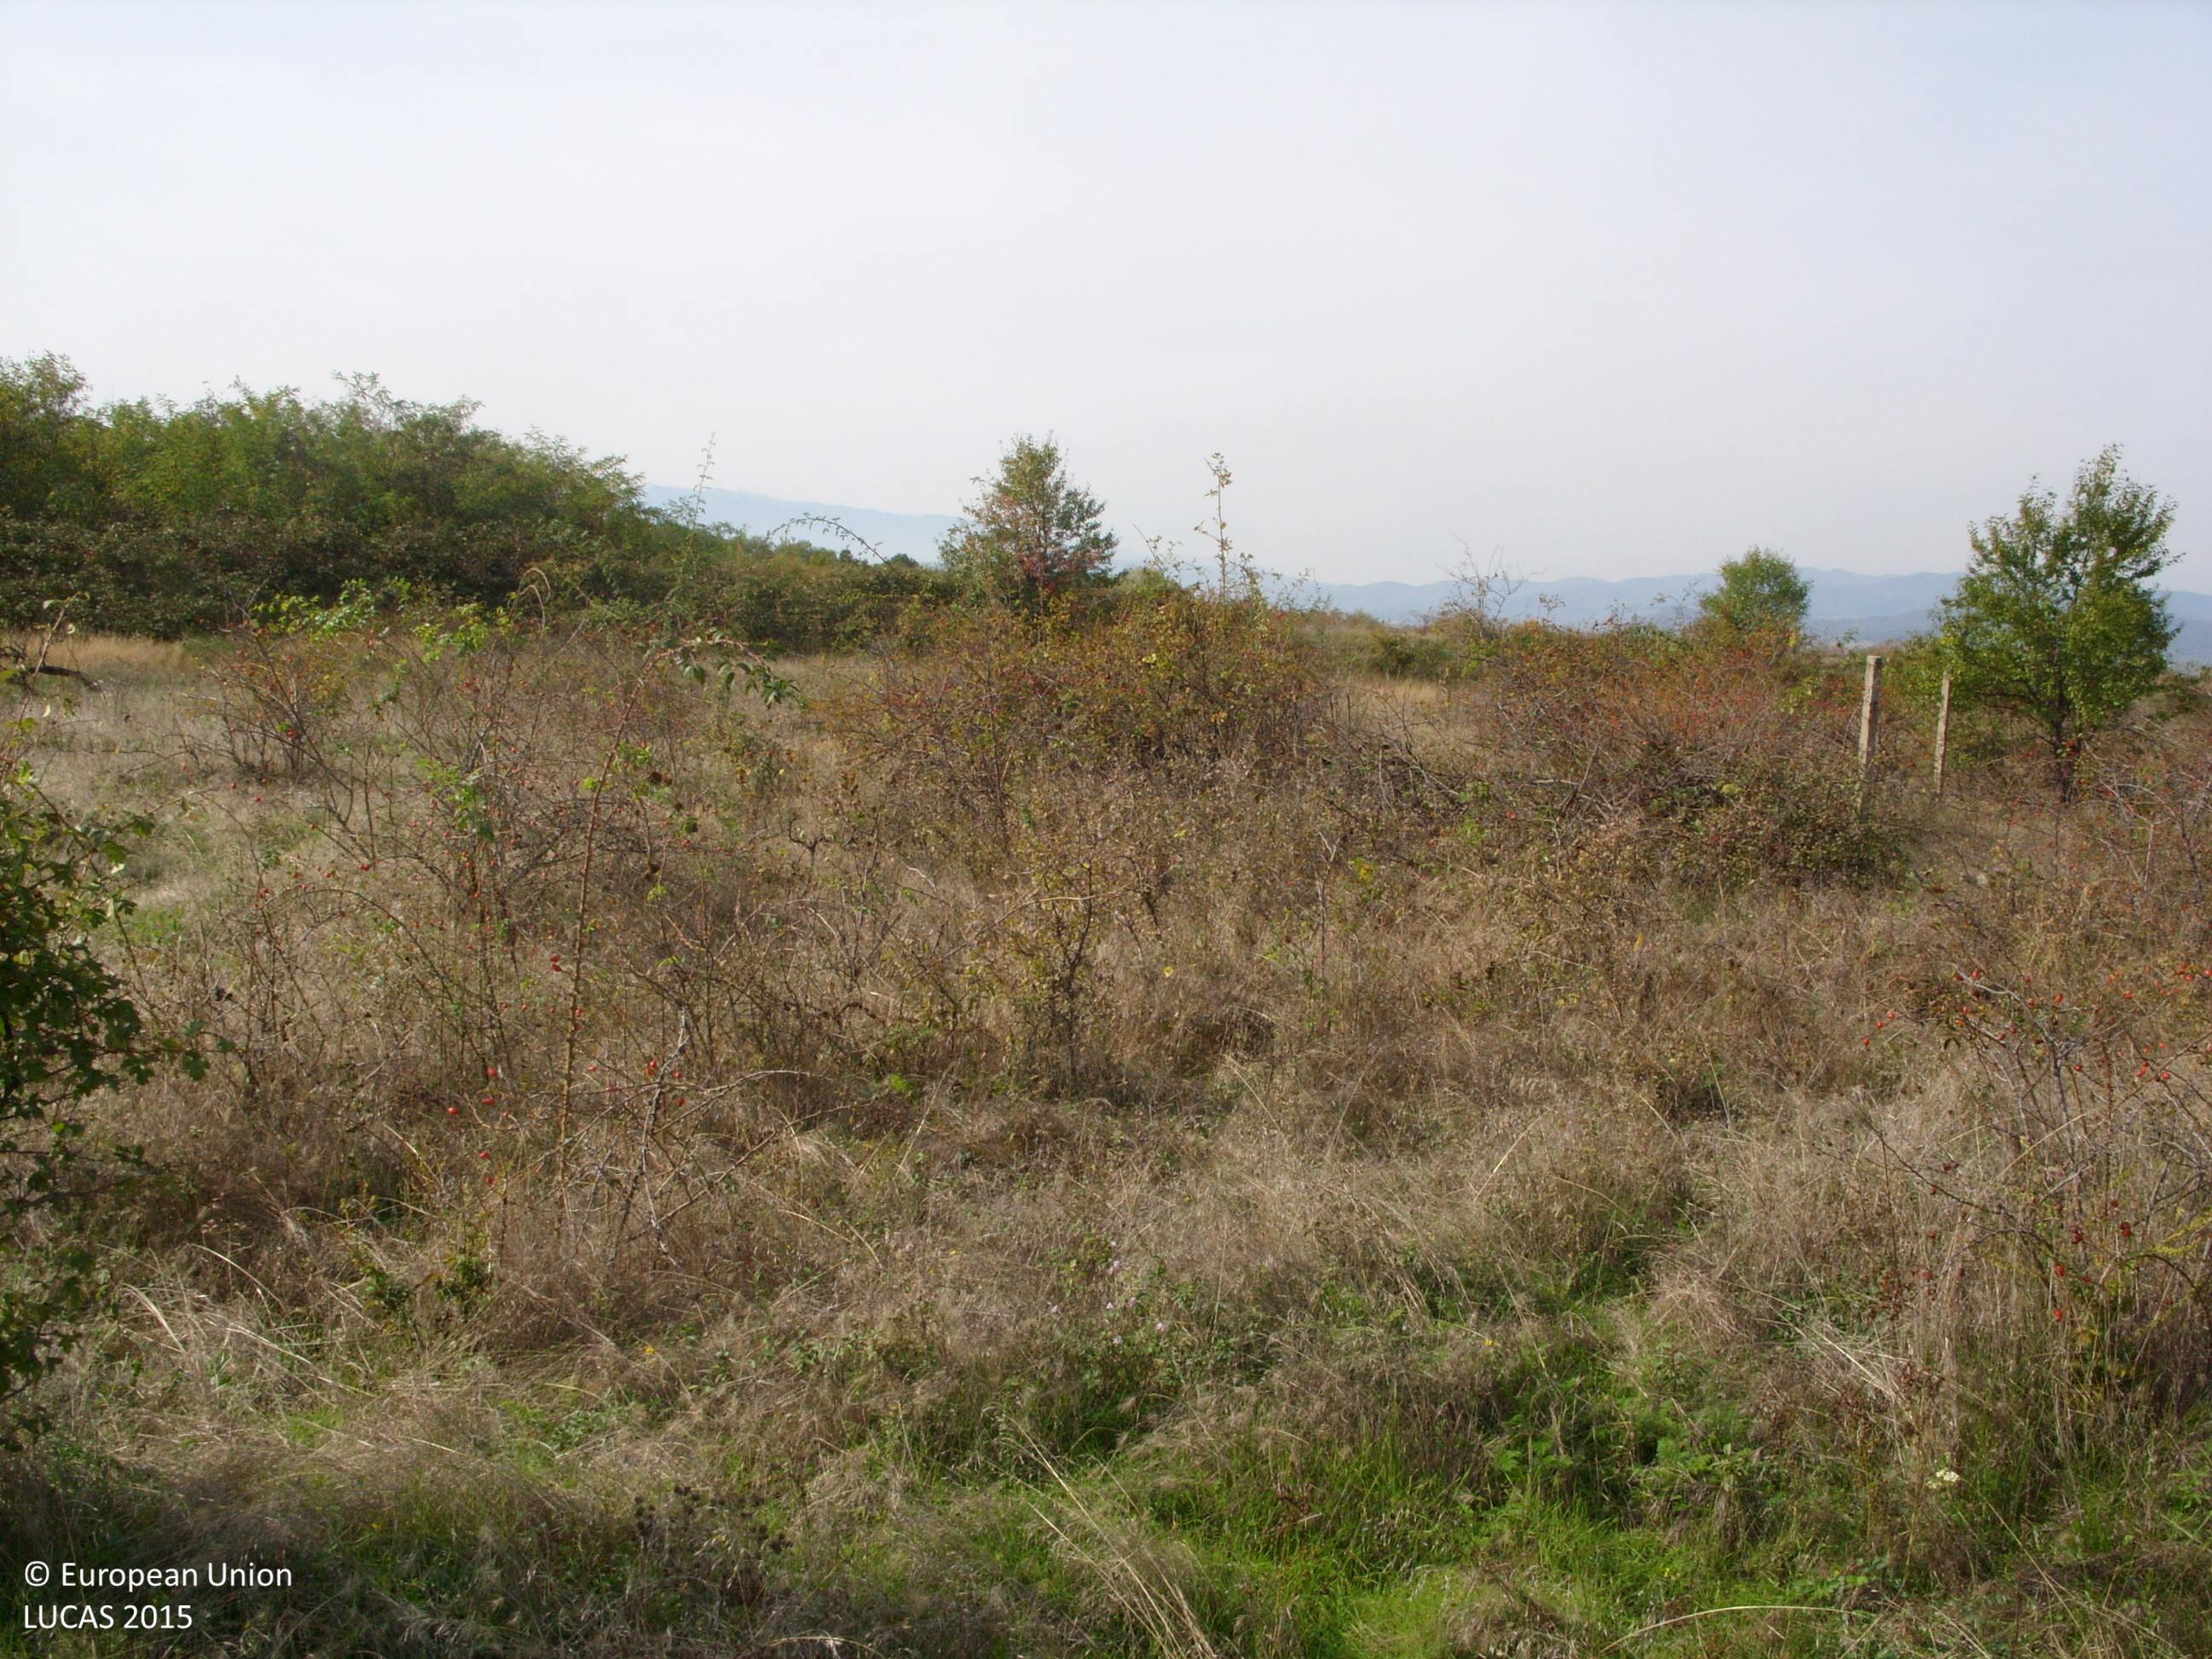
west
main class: Cropland
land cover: Vineyards
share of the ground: 50 - 75 %
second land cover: Spontaneously vegetated surfaces
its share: > 75 %
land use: Abandoned areas
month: October
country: BG
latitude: 42.2713
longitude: 24.1925
